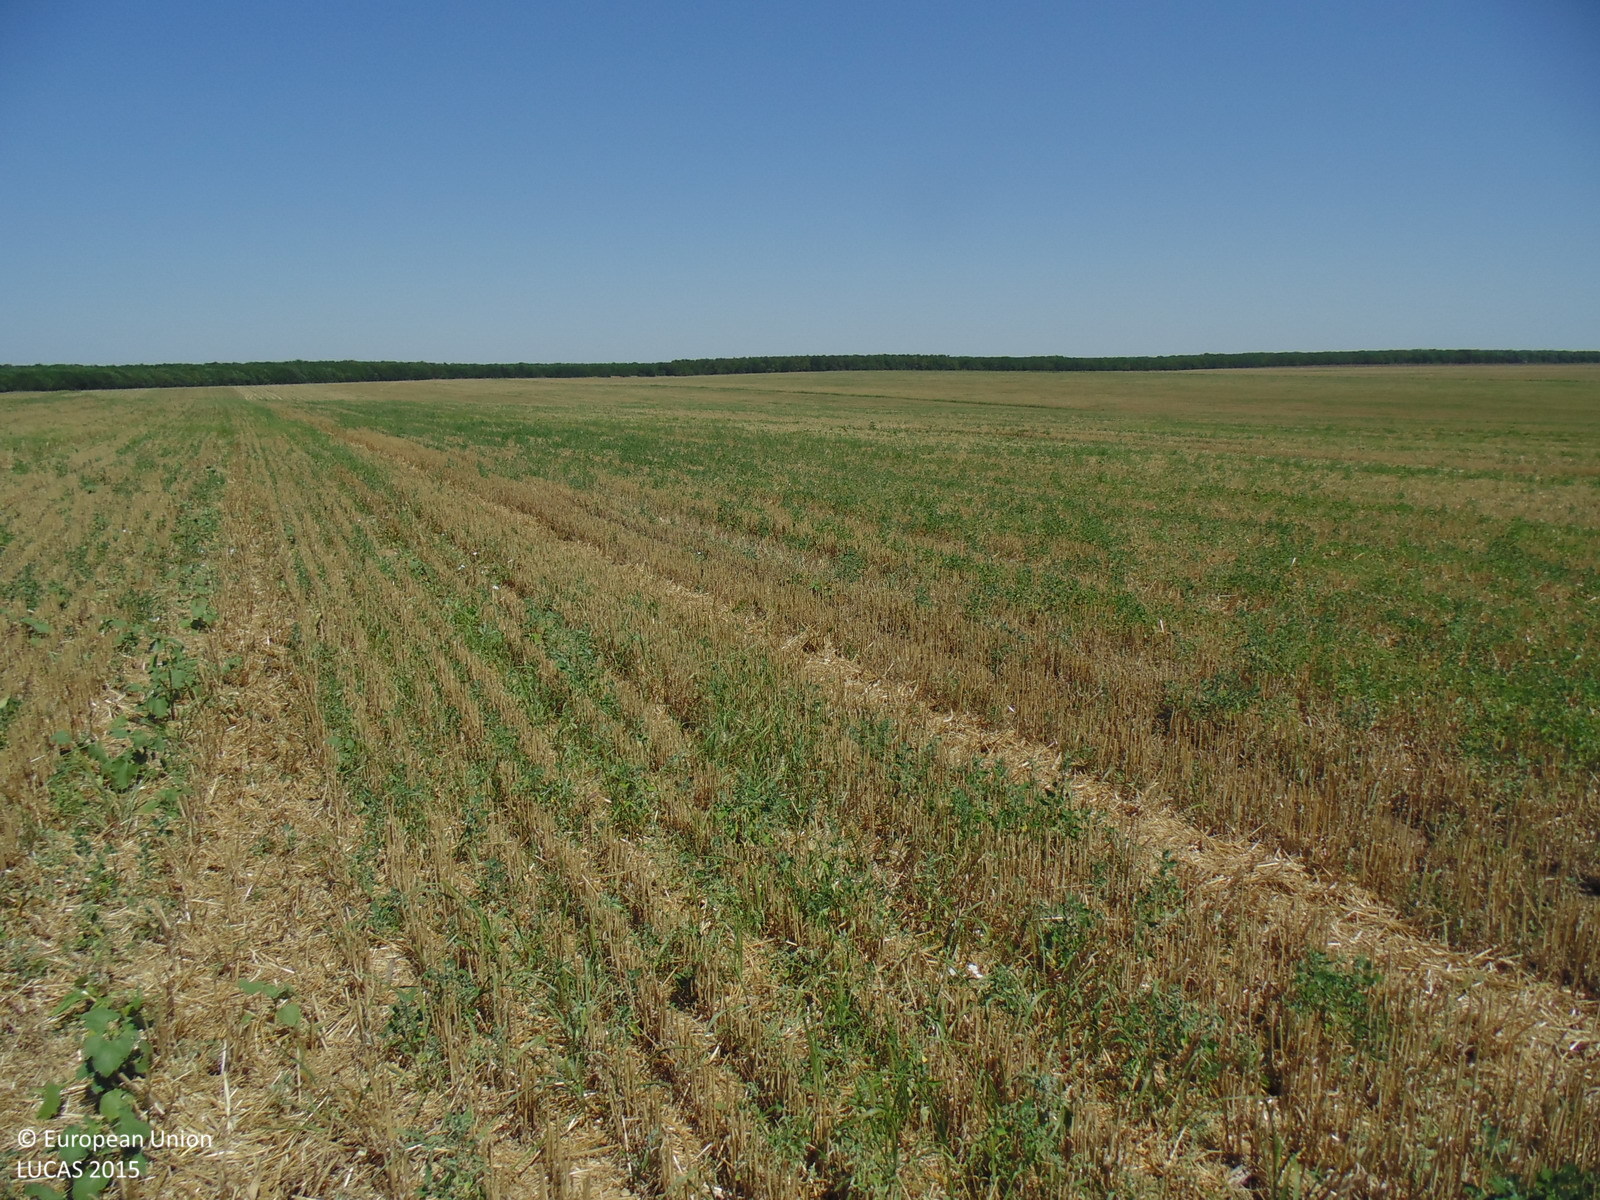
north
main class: Cropland
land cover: Common wheat
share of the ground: 25 - 50 %
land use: Agriculture (excluding fallow land and kitchen gardens)
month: August
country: BG
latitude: 43.5437
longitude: 28.1586
